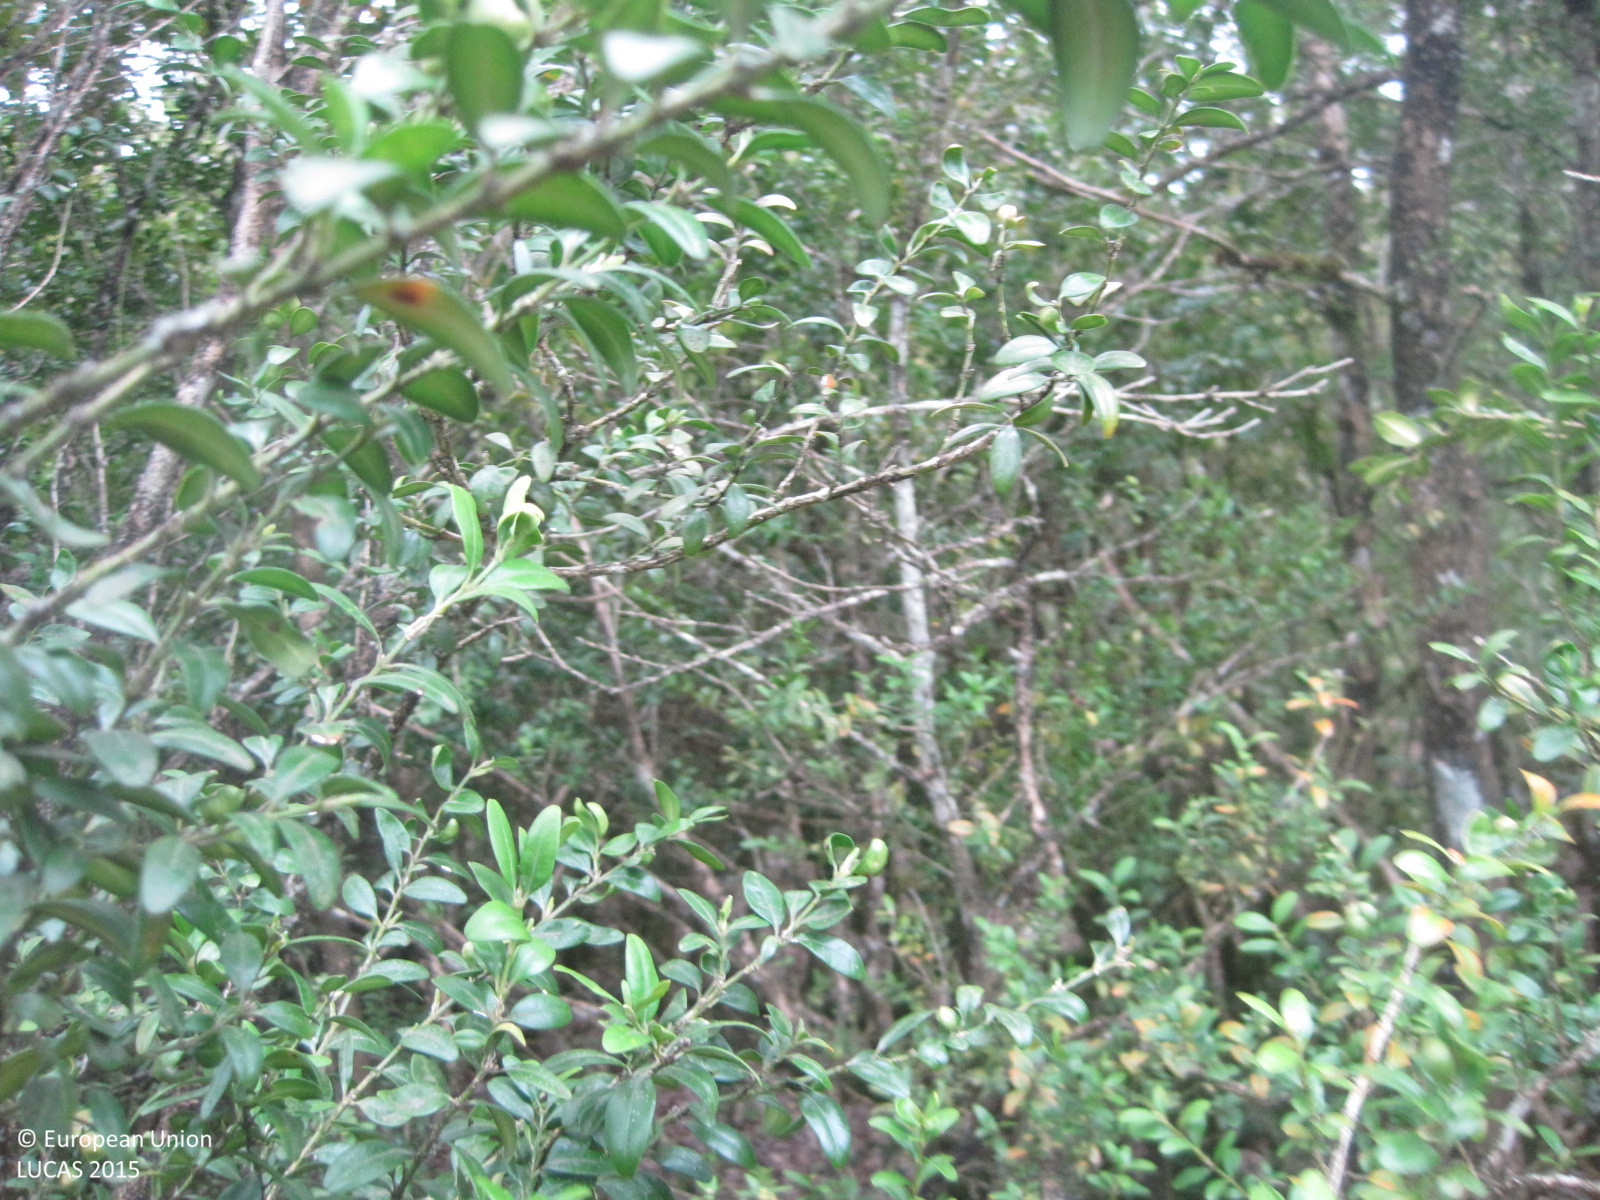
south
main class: Woodland
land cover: Broadleaved woodland
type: broadleaved evergreen forest
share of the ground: > 75 %
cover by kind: shrubs 60 %, broadleaved forest trees 40 %
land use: Semi-natural and natural areas not in use
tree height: > 5 m
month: April
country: ES
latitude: 42.7198
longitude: -2.1699
